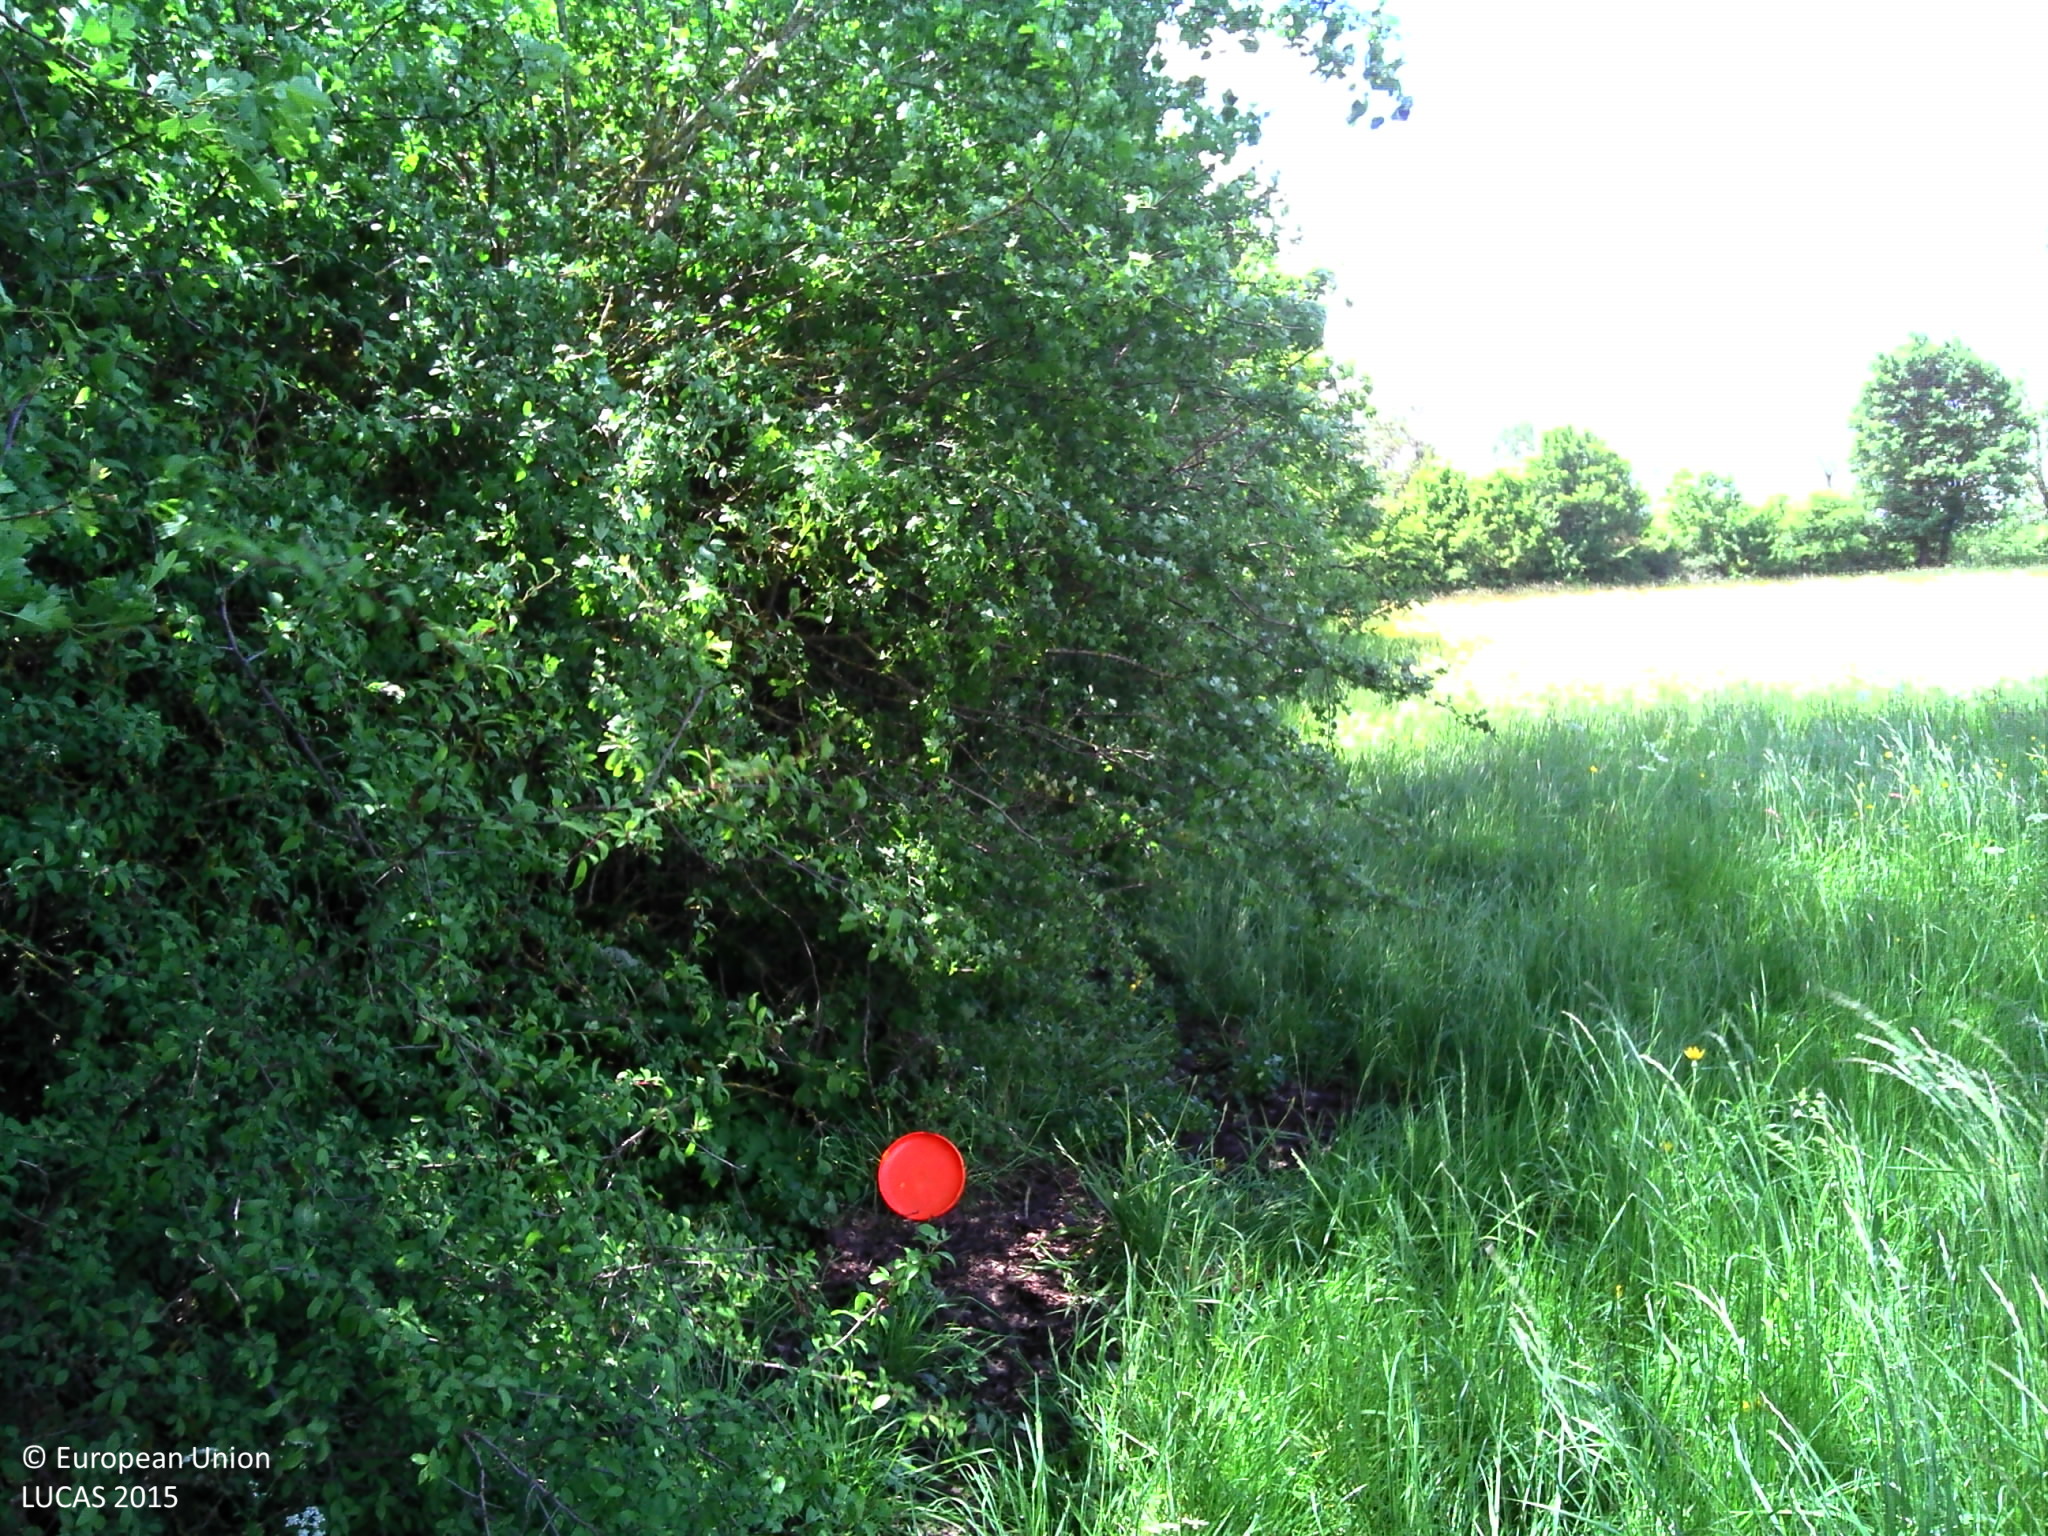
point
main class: Grassland
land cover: Grassland without tree/shrub cover
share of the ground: > 75 %
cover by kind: herbaceous plants 100 %
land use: Agriculture (excluding fallow land and kitchen gardens)
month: May
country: FR
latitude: 44.3212
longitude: 3.1213
